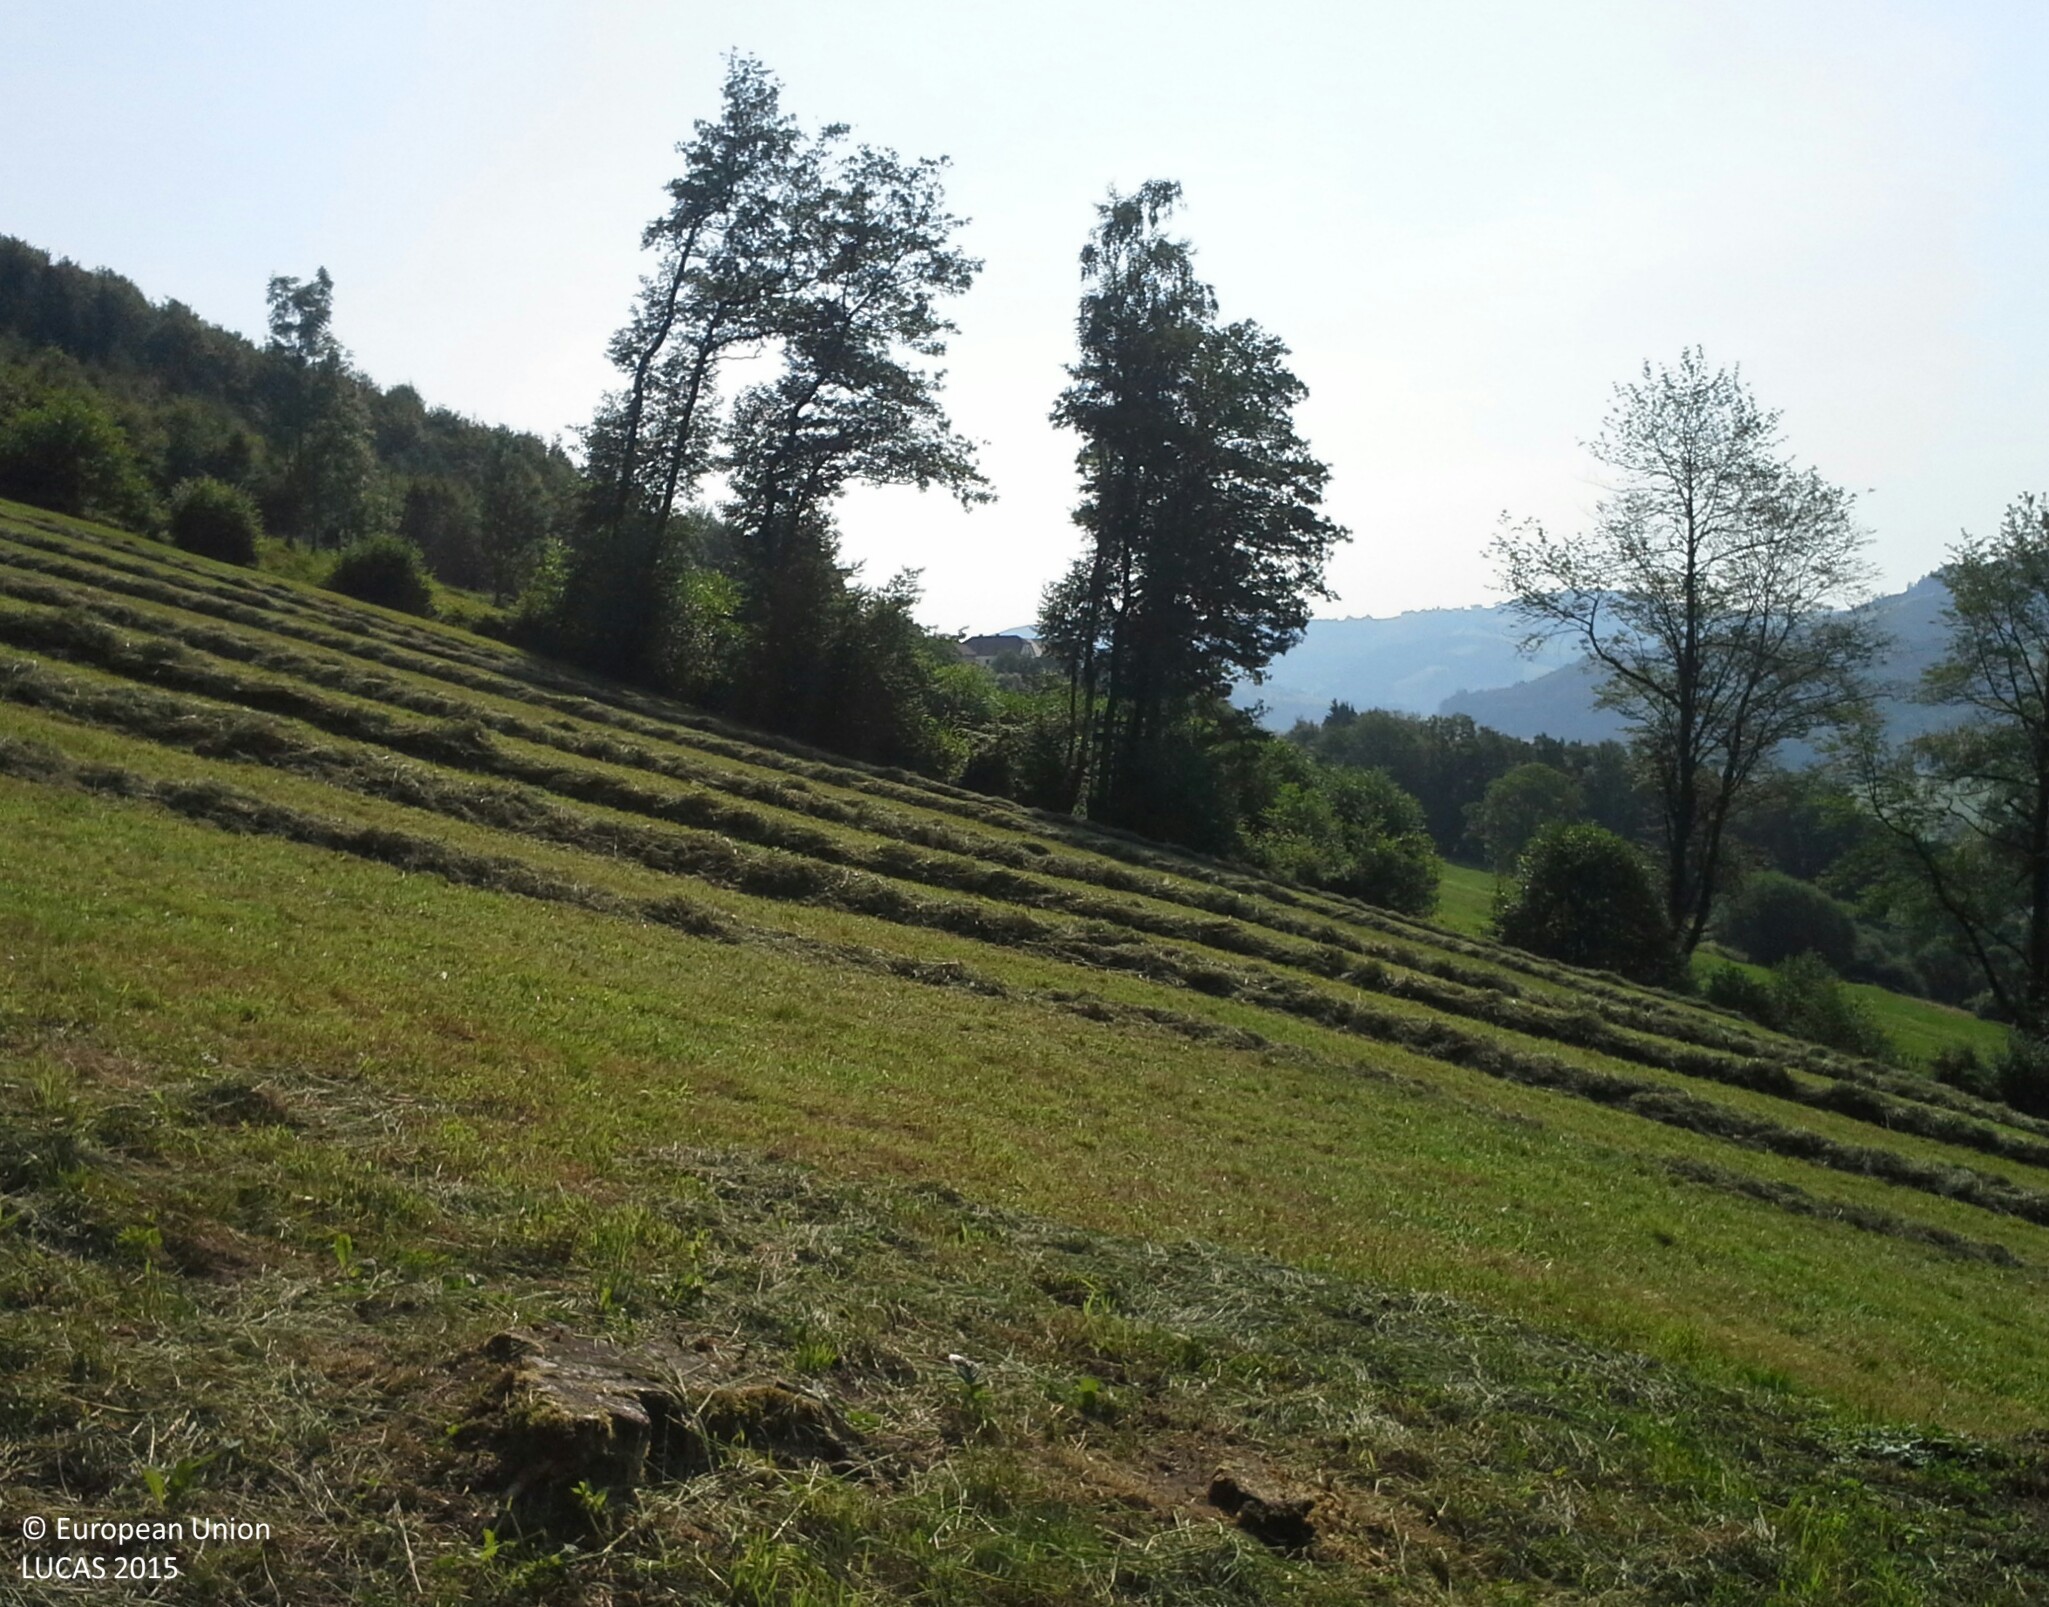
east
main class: Grassland
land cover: Grassland without tree/shrub cover
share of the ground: > 75 %
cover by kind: herbaceous plants 95 %, unconsolidated bare surface 5 %
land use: Agriculture (excluding fallow land and kitchen gardens)
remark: Clear cut
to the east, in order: Grassland without tree/shrub cover; Broadleaved woodland; Rivers and streams; Spontaneously vegetated surfaces; Broadleaved woodland; Grassland without tree/shrub cover; Broadleaved woodland; Paved roads, cycling and walking lanes; Grass margins; Broadleaved woodland
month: July
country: AT
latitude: 48.0391
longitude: 14.9770
